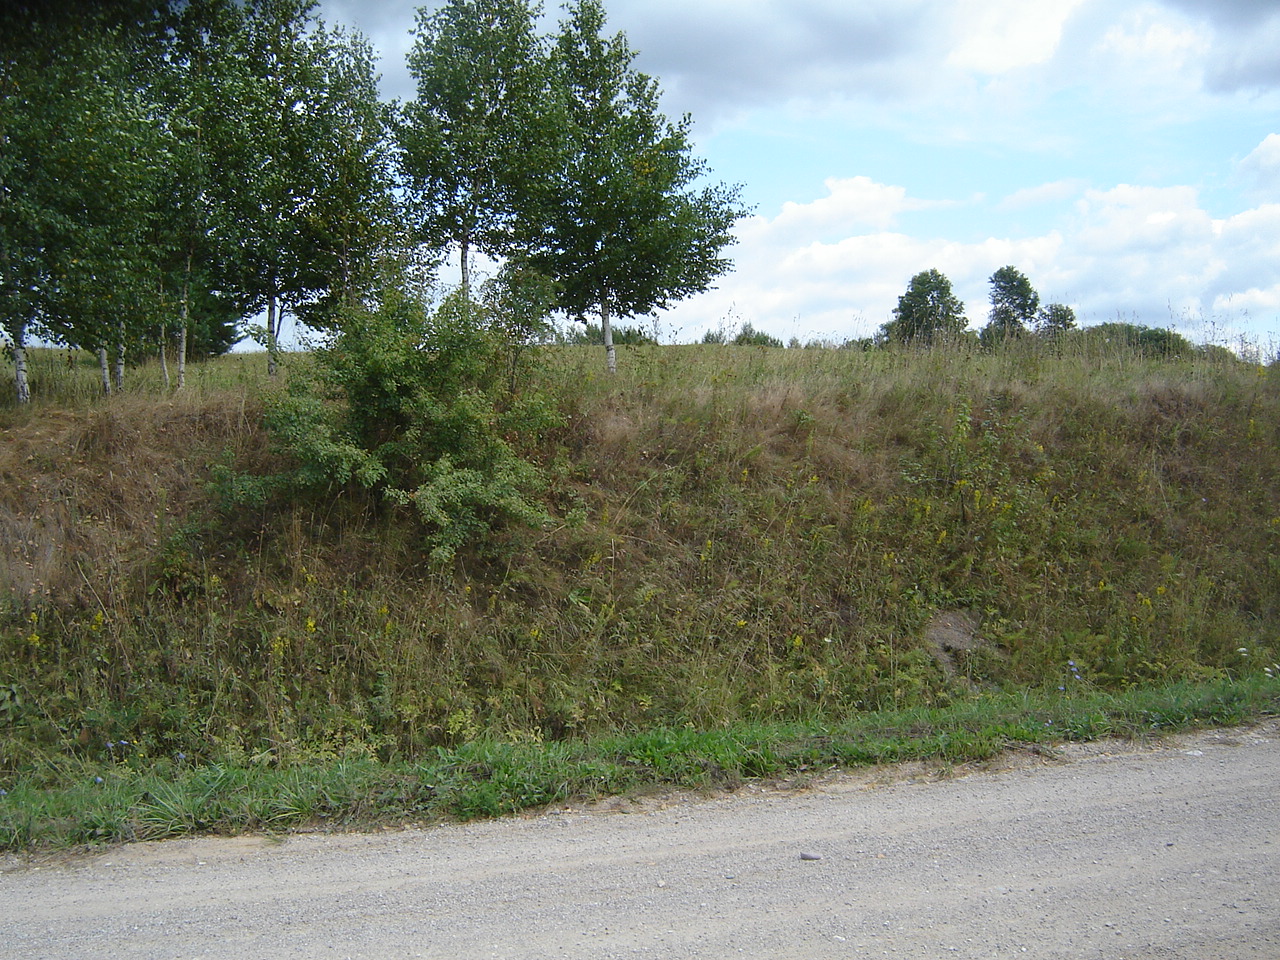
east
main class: Woodland
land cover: Pine dominated coniferous woodland
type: hemiboreal forest and nemoral coniferous forest and mixed broadleaved-coniferous forest
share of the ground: 50 - 75 %
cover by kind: coniferous forest trees 50 %, herbaceous plants 40 %, broadleaved forest trees 5 %, shrubs 5 %
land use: Residential
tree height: > 5 m
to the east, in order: Pine dominated coniferous woodland; Fences; Pine dominated coniferous woodland; Tracks; Grass margins; Pine dominated mixed woodland; Fences; Grassland without tree/shrub cover; Paved roads, cycling and walking lanes; Grass margins; Pine dominated mixed woodland; Tracks; Grass margins; Common wheat; Grassland without tree/shrub cover; Broadleaved woodland; Grassland without tree/shrub cover
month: August
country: LT
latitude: 54.6191
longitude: 24.7114
